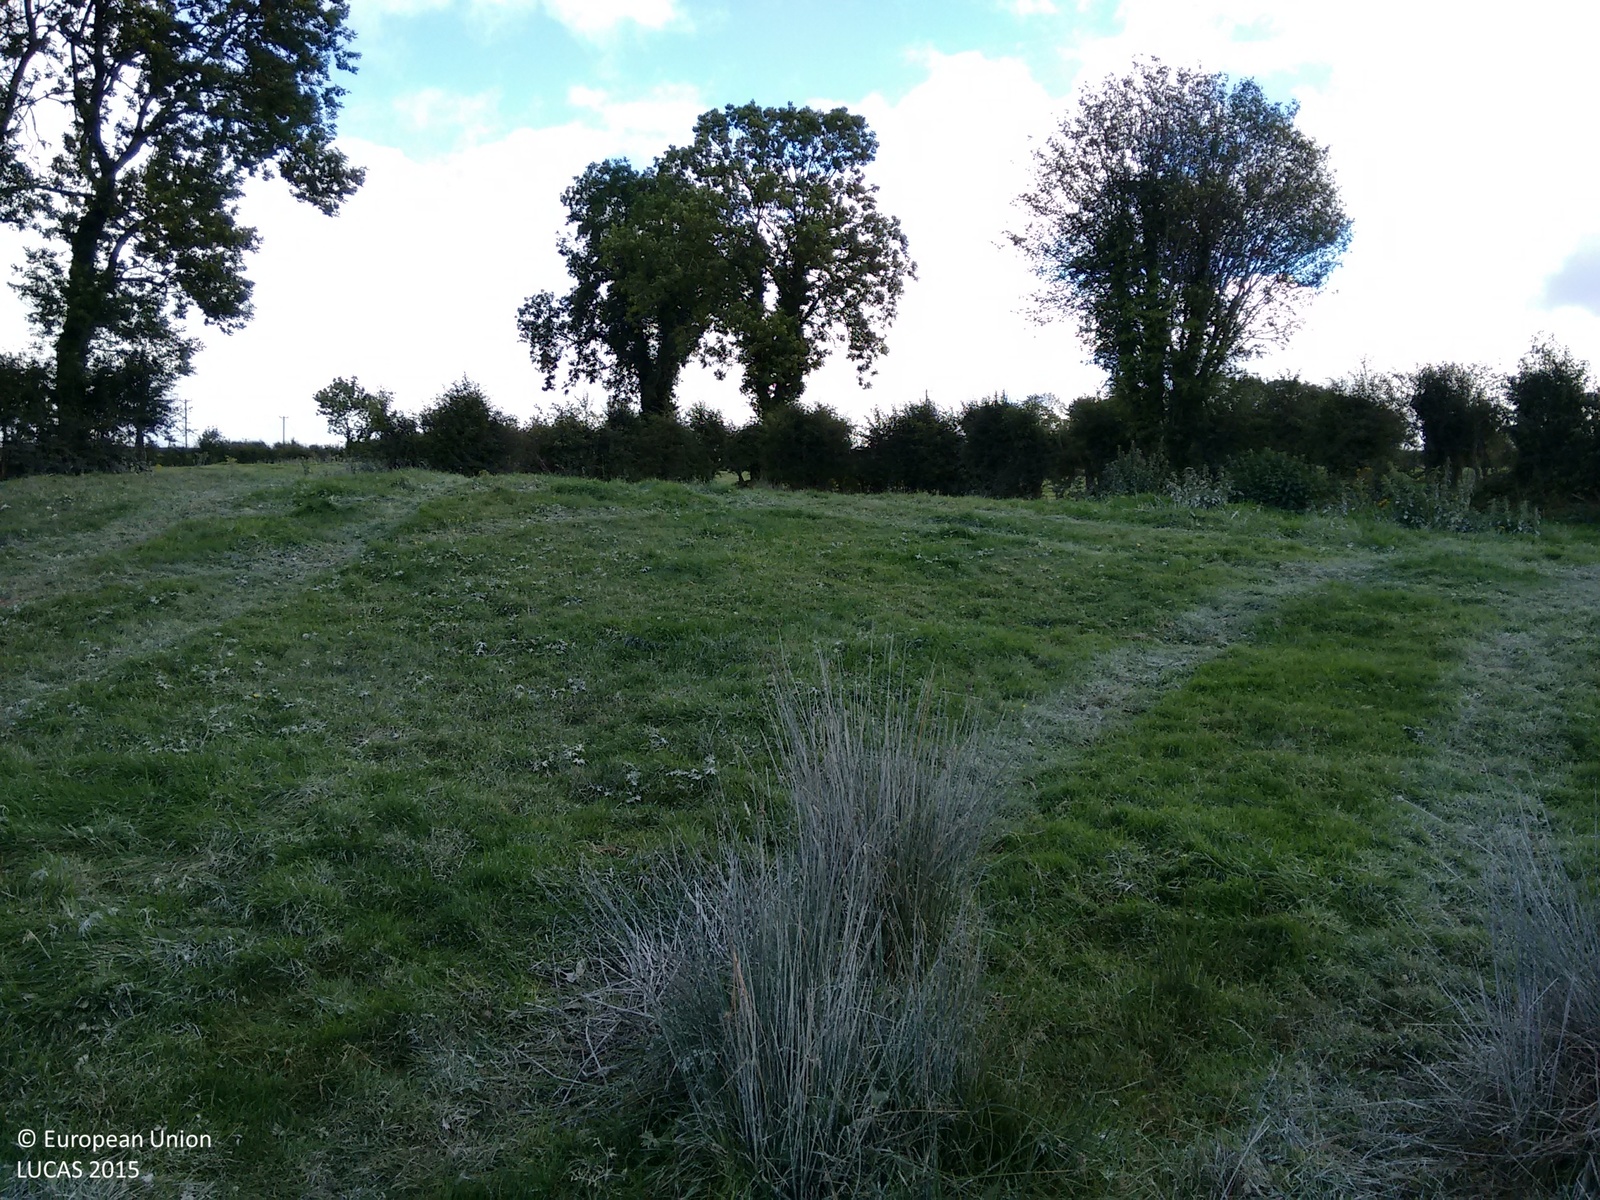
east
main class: Grassland
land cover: Grassland without tree/shrub cover
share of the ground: > 75 %
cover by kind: herbaceous plants 100 %
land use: Agriculture (excluding fallow land and kitchen gardens)
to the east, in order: Grassland without tree/shrub cover; Managed hedges; Grassland without tree/shrub cover; Managed hedges; Artificial constructions in urban areas; Managed hedges; Ditches and canals; Shrubland without tree cover; Fences; Grassland without tree/shrub cover
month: September
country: IE
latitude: 54.1987
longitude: -6.8281
